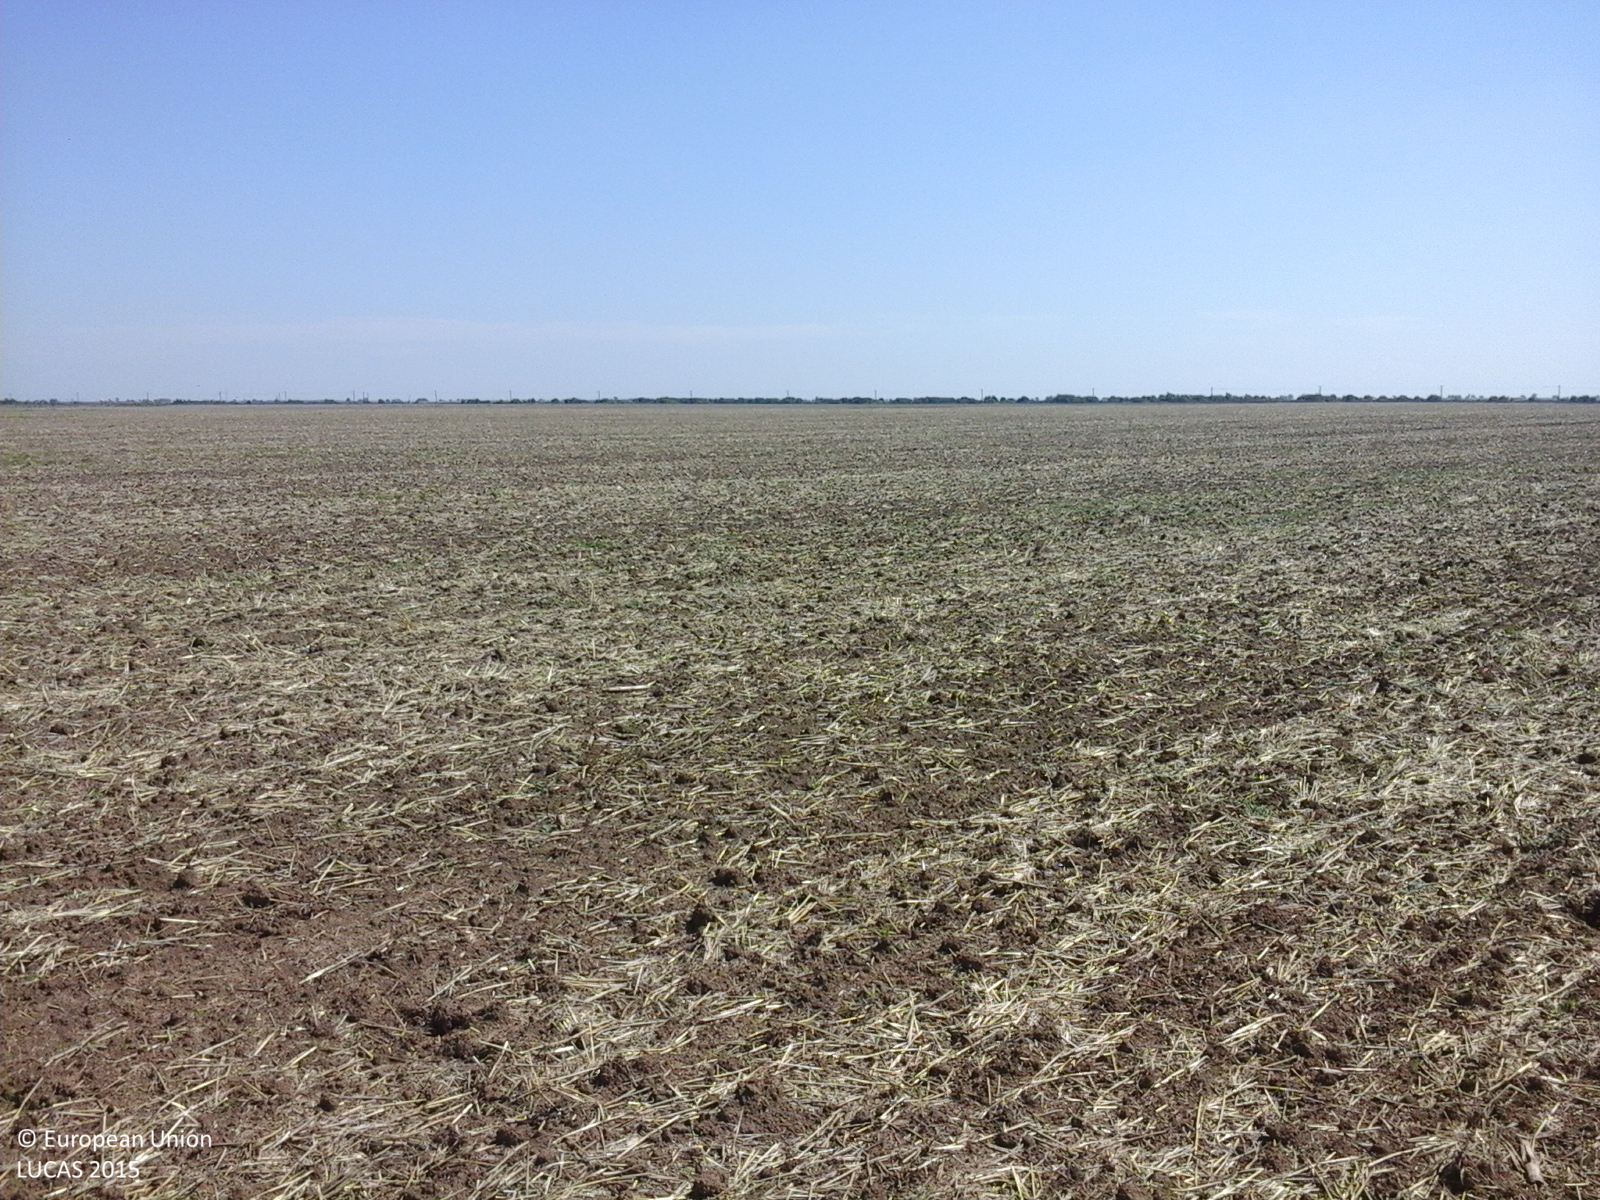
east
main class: Cropland
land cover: Common wheat
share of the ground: 25 - 50 %
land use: Agriculture (excluding fallow land and kitchen gardens)
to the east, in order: Common wheat
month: August
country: RO
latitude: 45.8933
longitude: 21.1525
